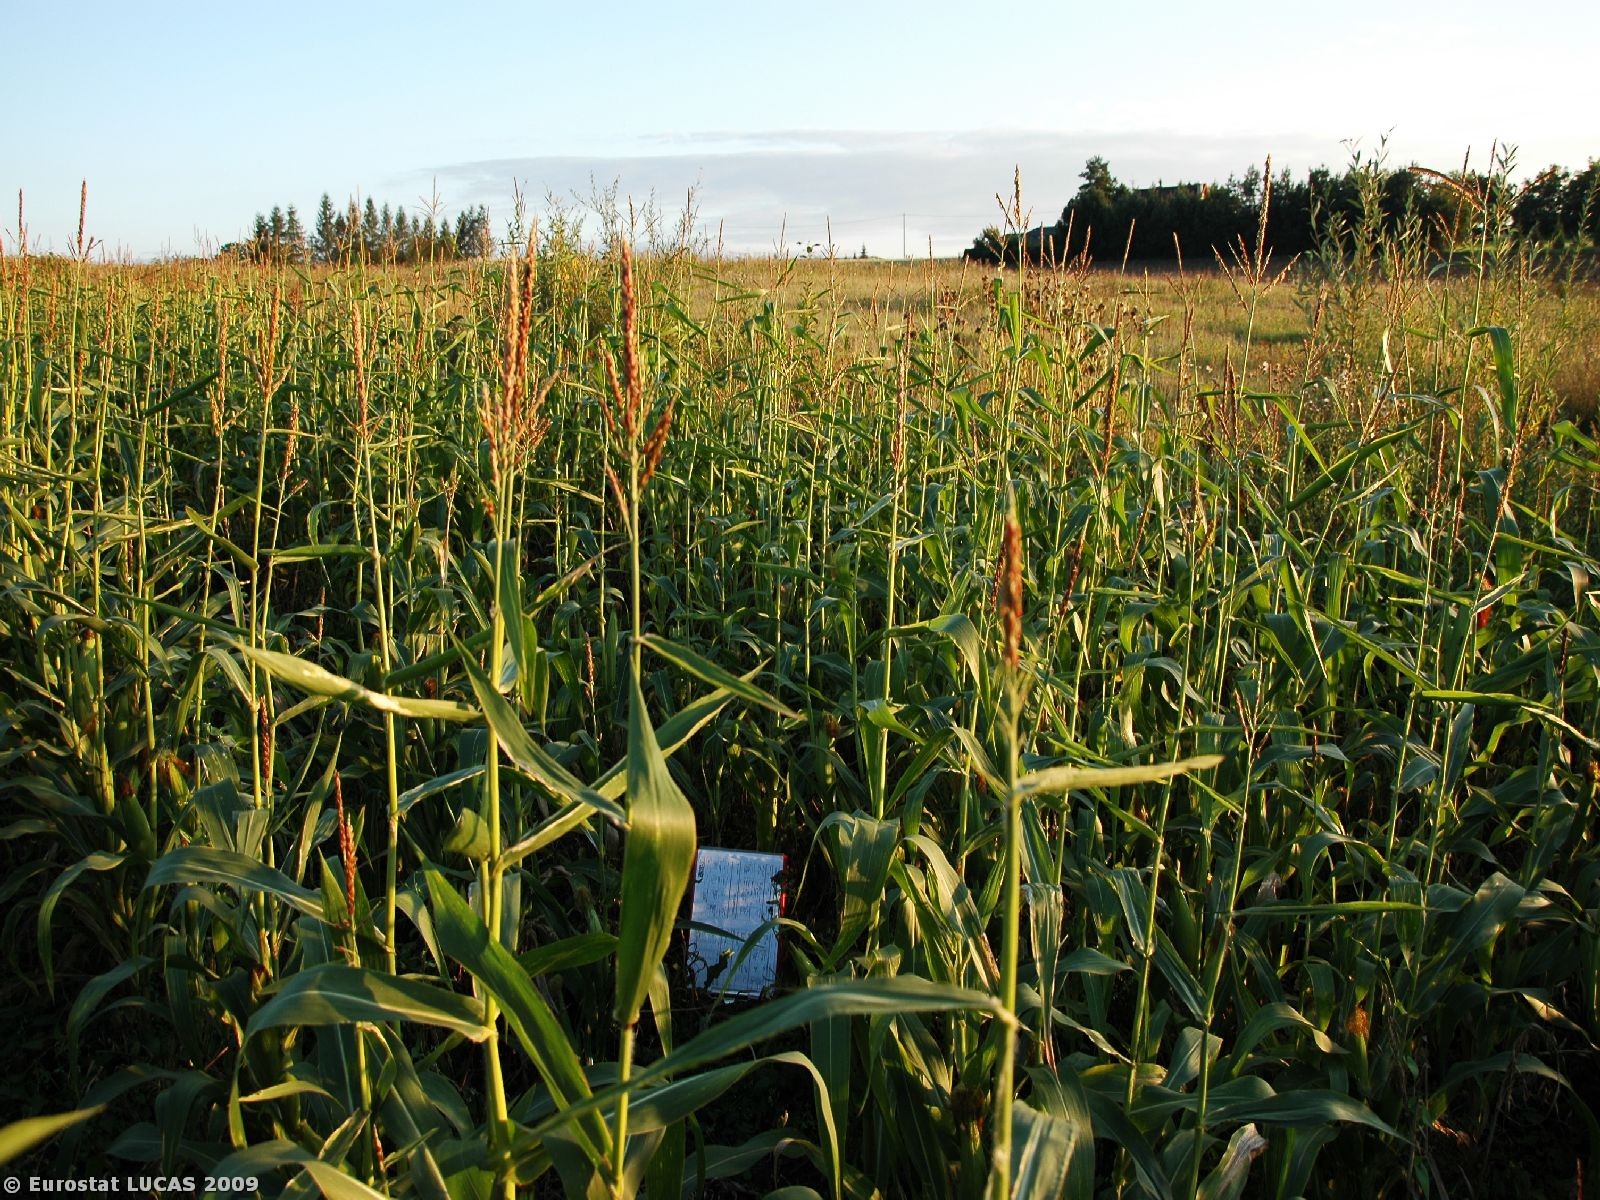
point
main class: Cropland
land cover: Maize
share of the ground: > 75 %
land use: Agriculture (excluding fallow land and kitchen gardens)
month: August
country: PL
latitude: 49.7767
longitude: 18.7274
